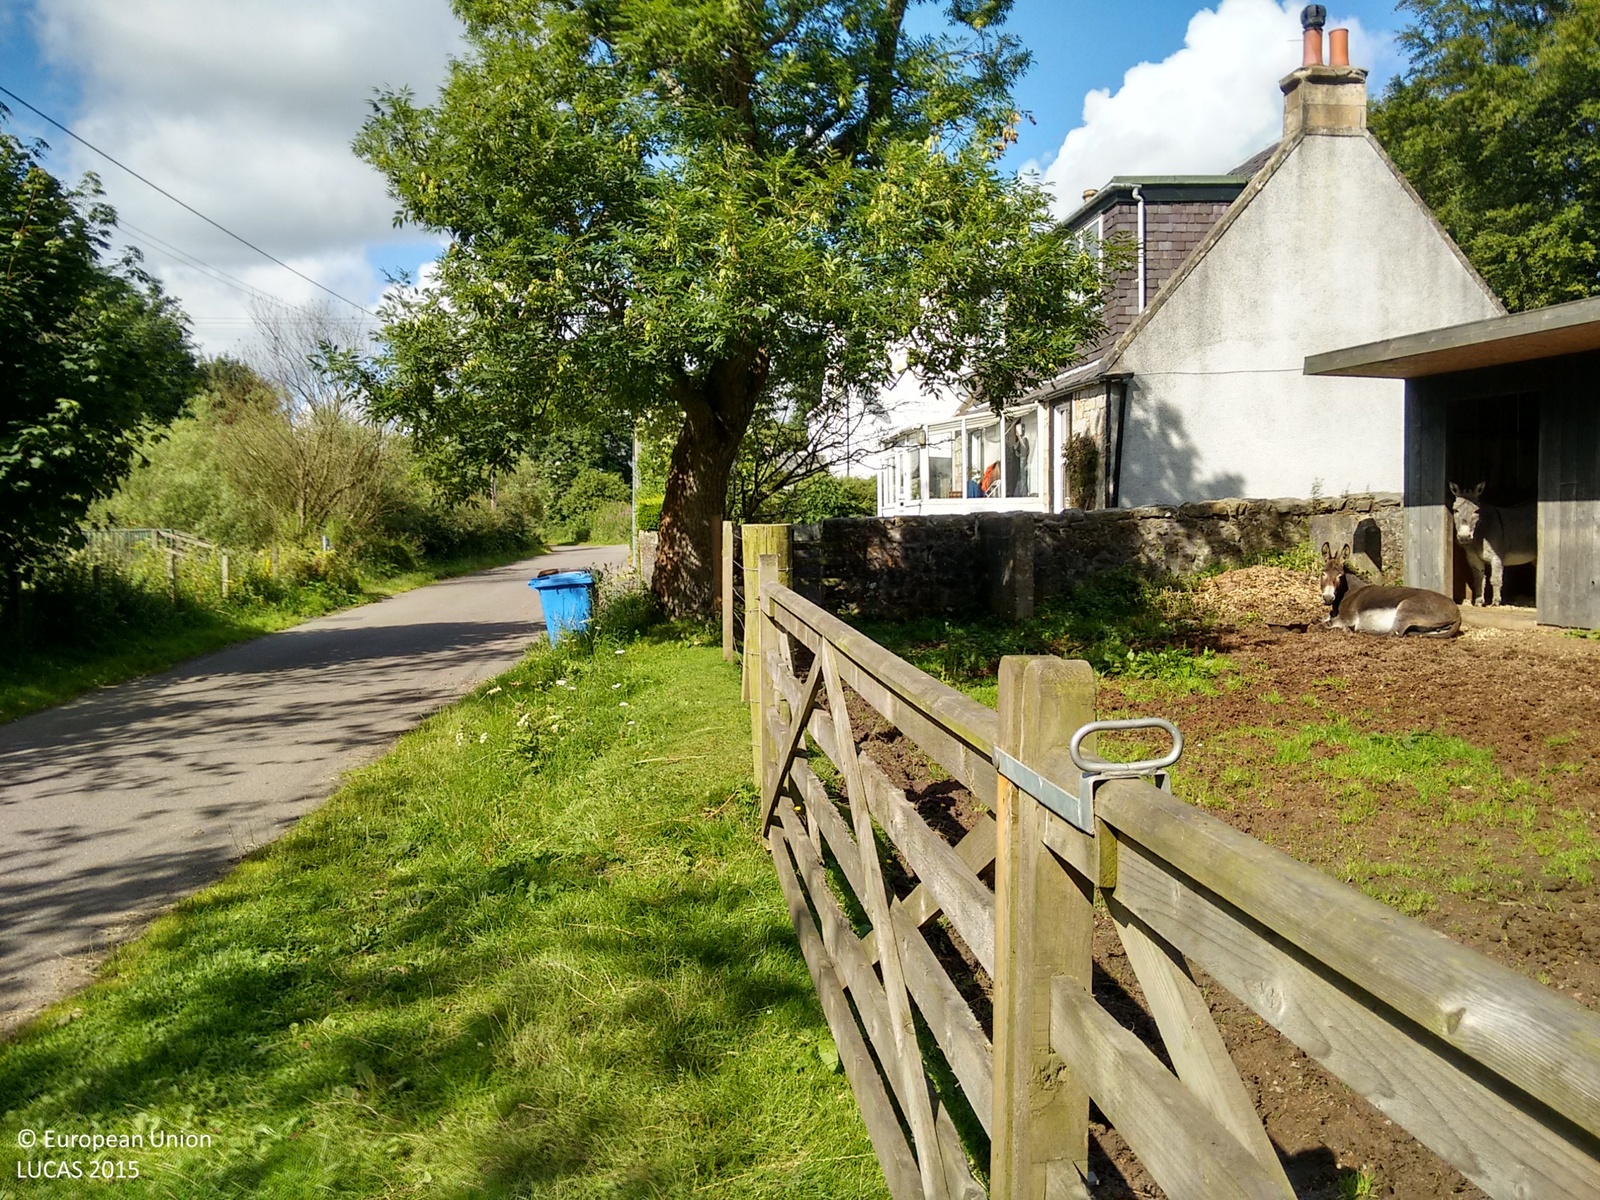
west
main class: Grassland
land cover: Grassland without tree/shrub cover
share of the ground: > 75 %
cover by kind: herbaceous plants 95 %, unconsolidated bare surface 5 %
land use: Agriculture (excluding fallow land and kitchen gardens)
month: August
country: GB
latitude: 55.9374
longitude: -3.7376
